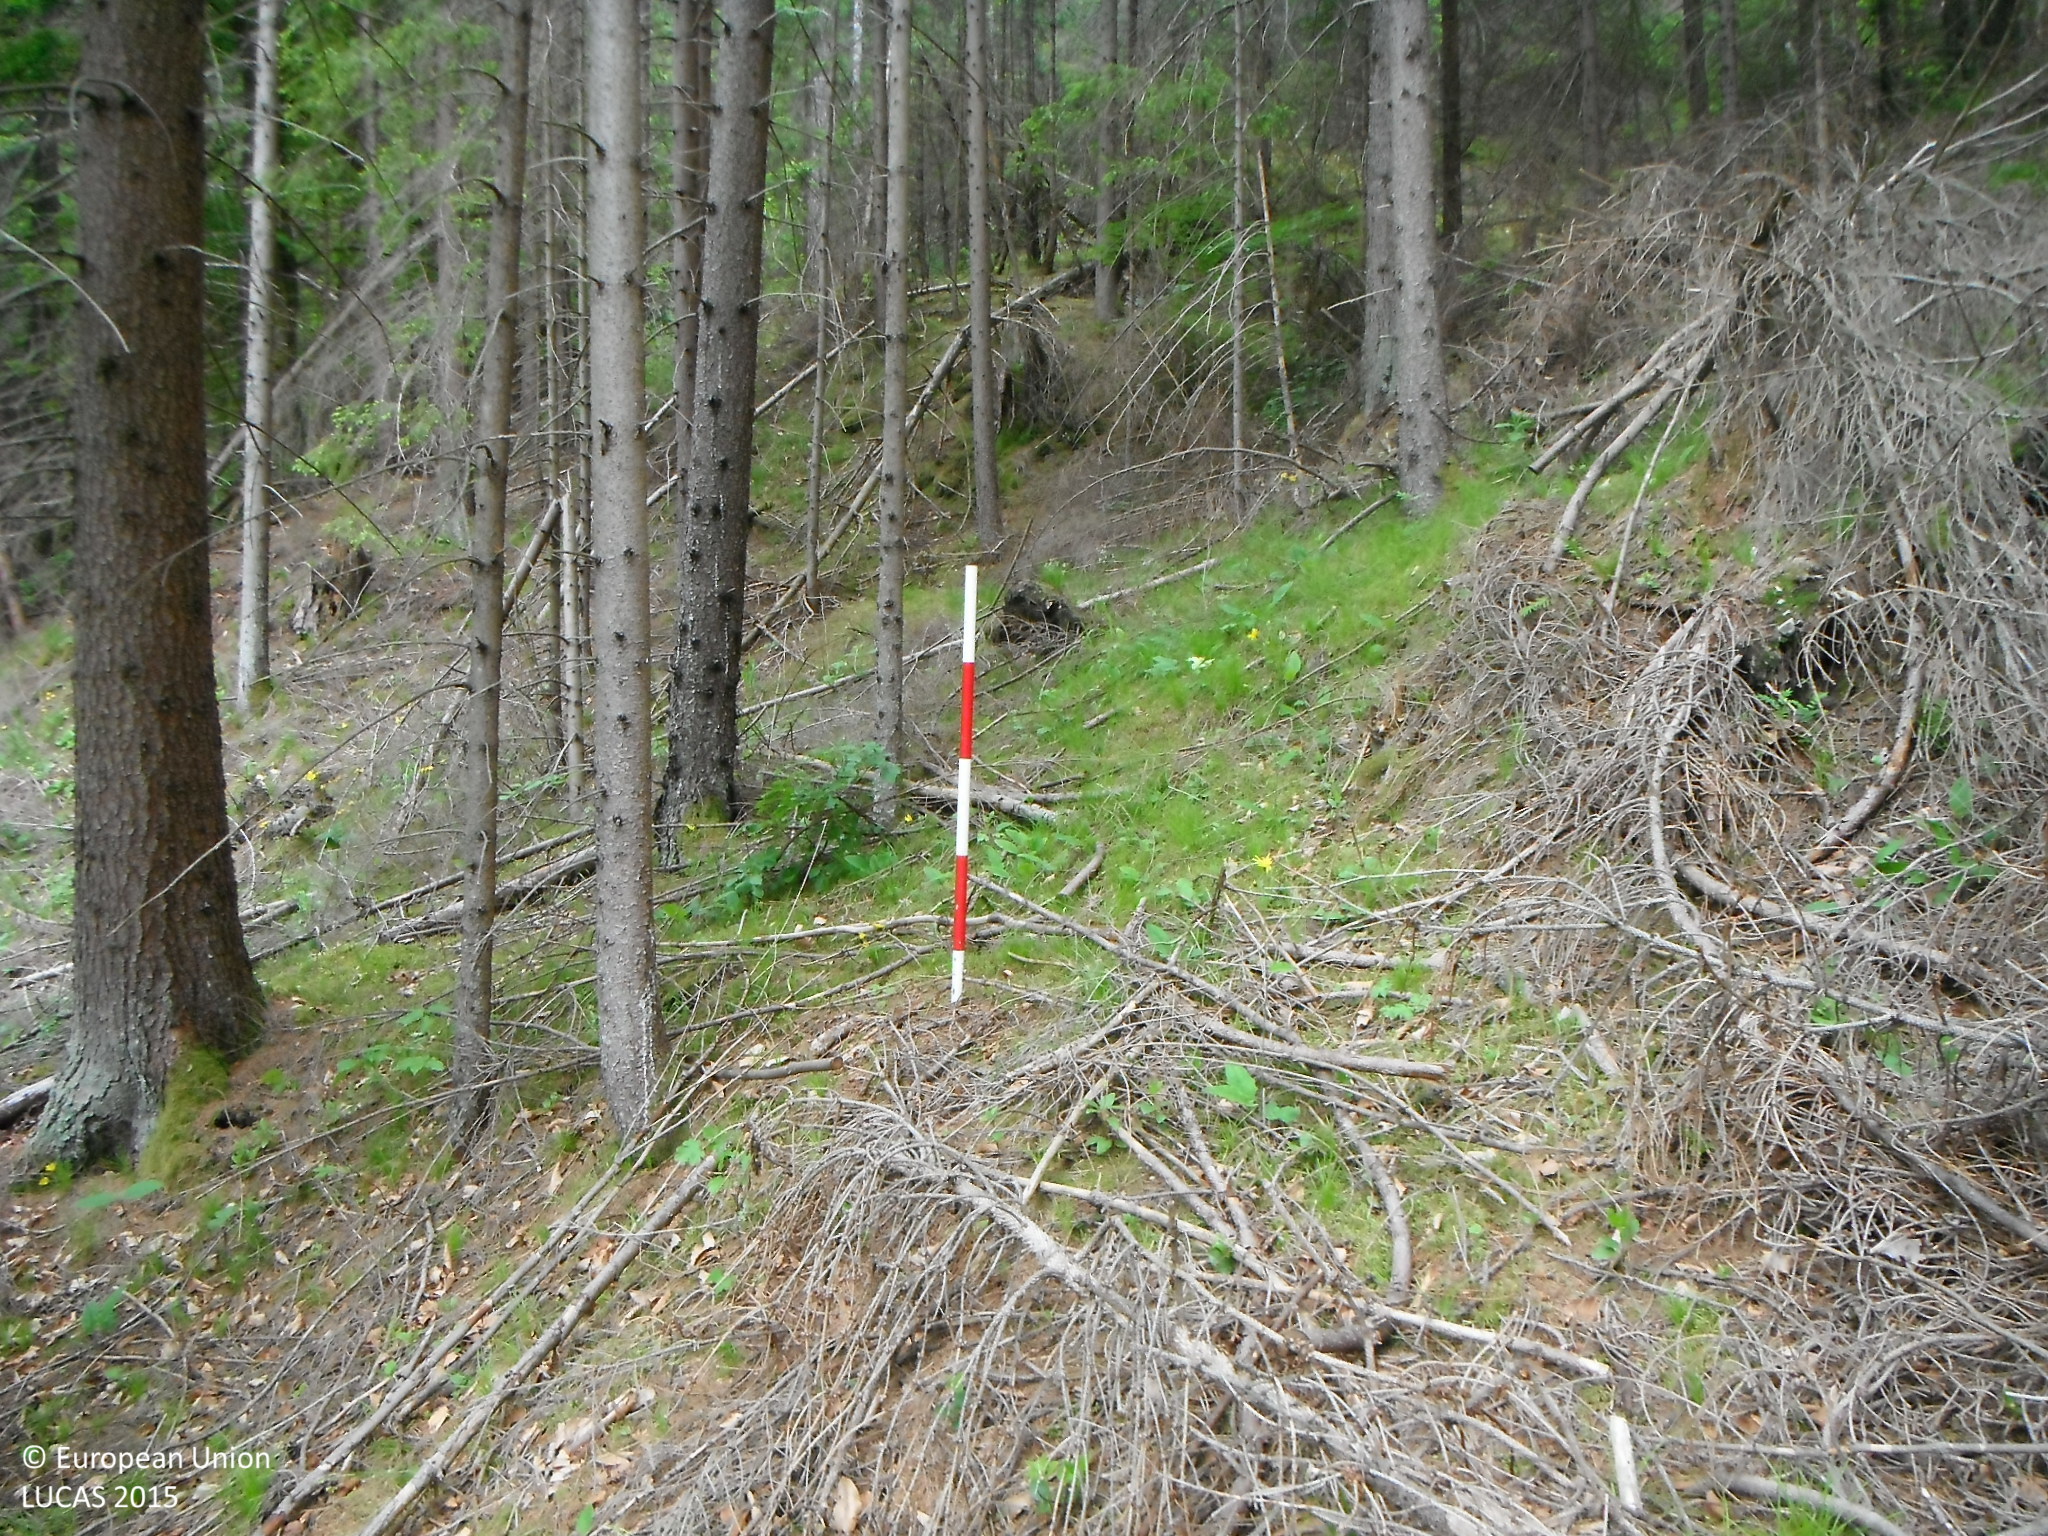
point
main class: Woodland
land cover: Spruce dominated coniferous woodland
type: alpine coniferous forest
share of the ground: > 75 %
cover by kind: coniferous forest trees 95 %, broadleaved forest trees 5 %
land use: Forestry
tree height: > 5 m
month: June
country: SK
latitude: 48.7810
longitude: 19.4013
